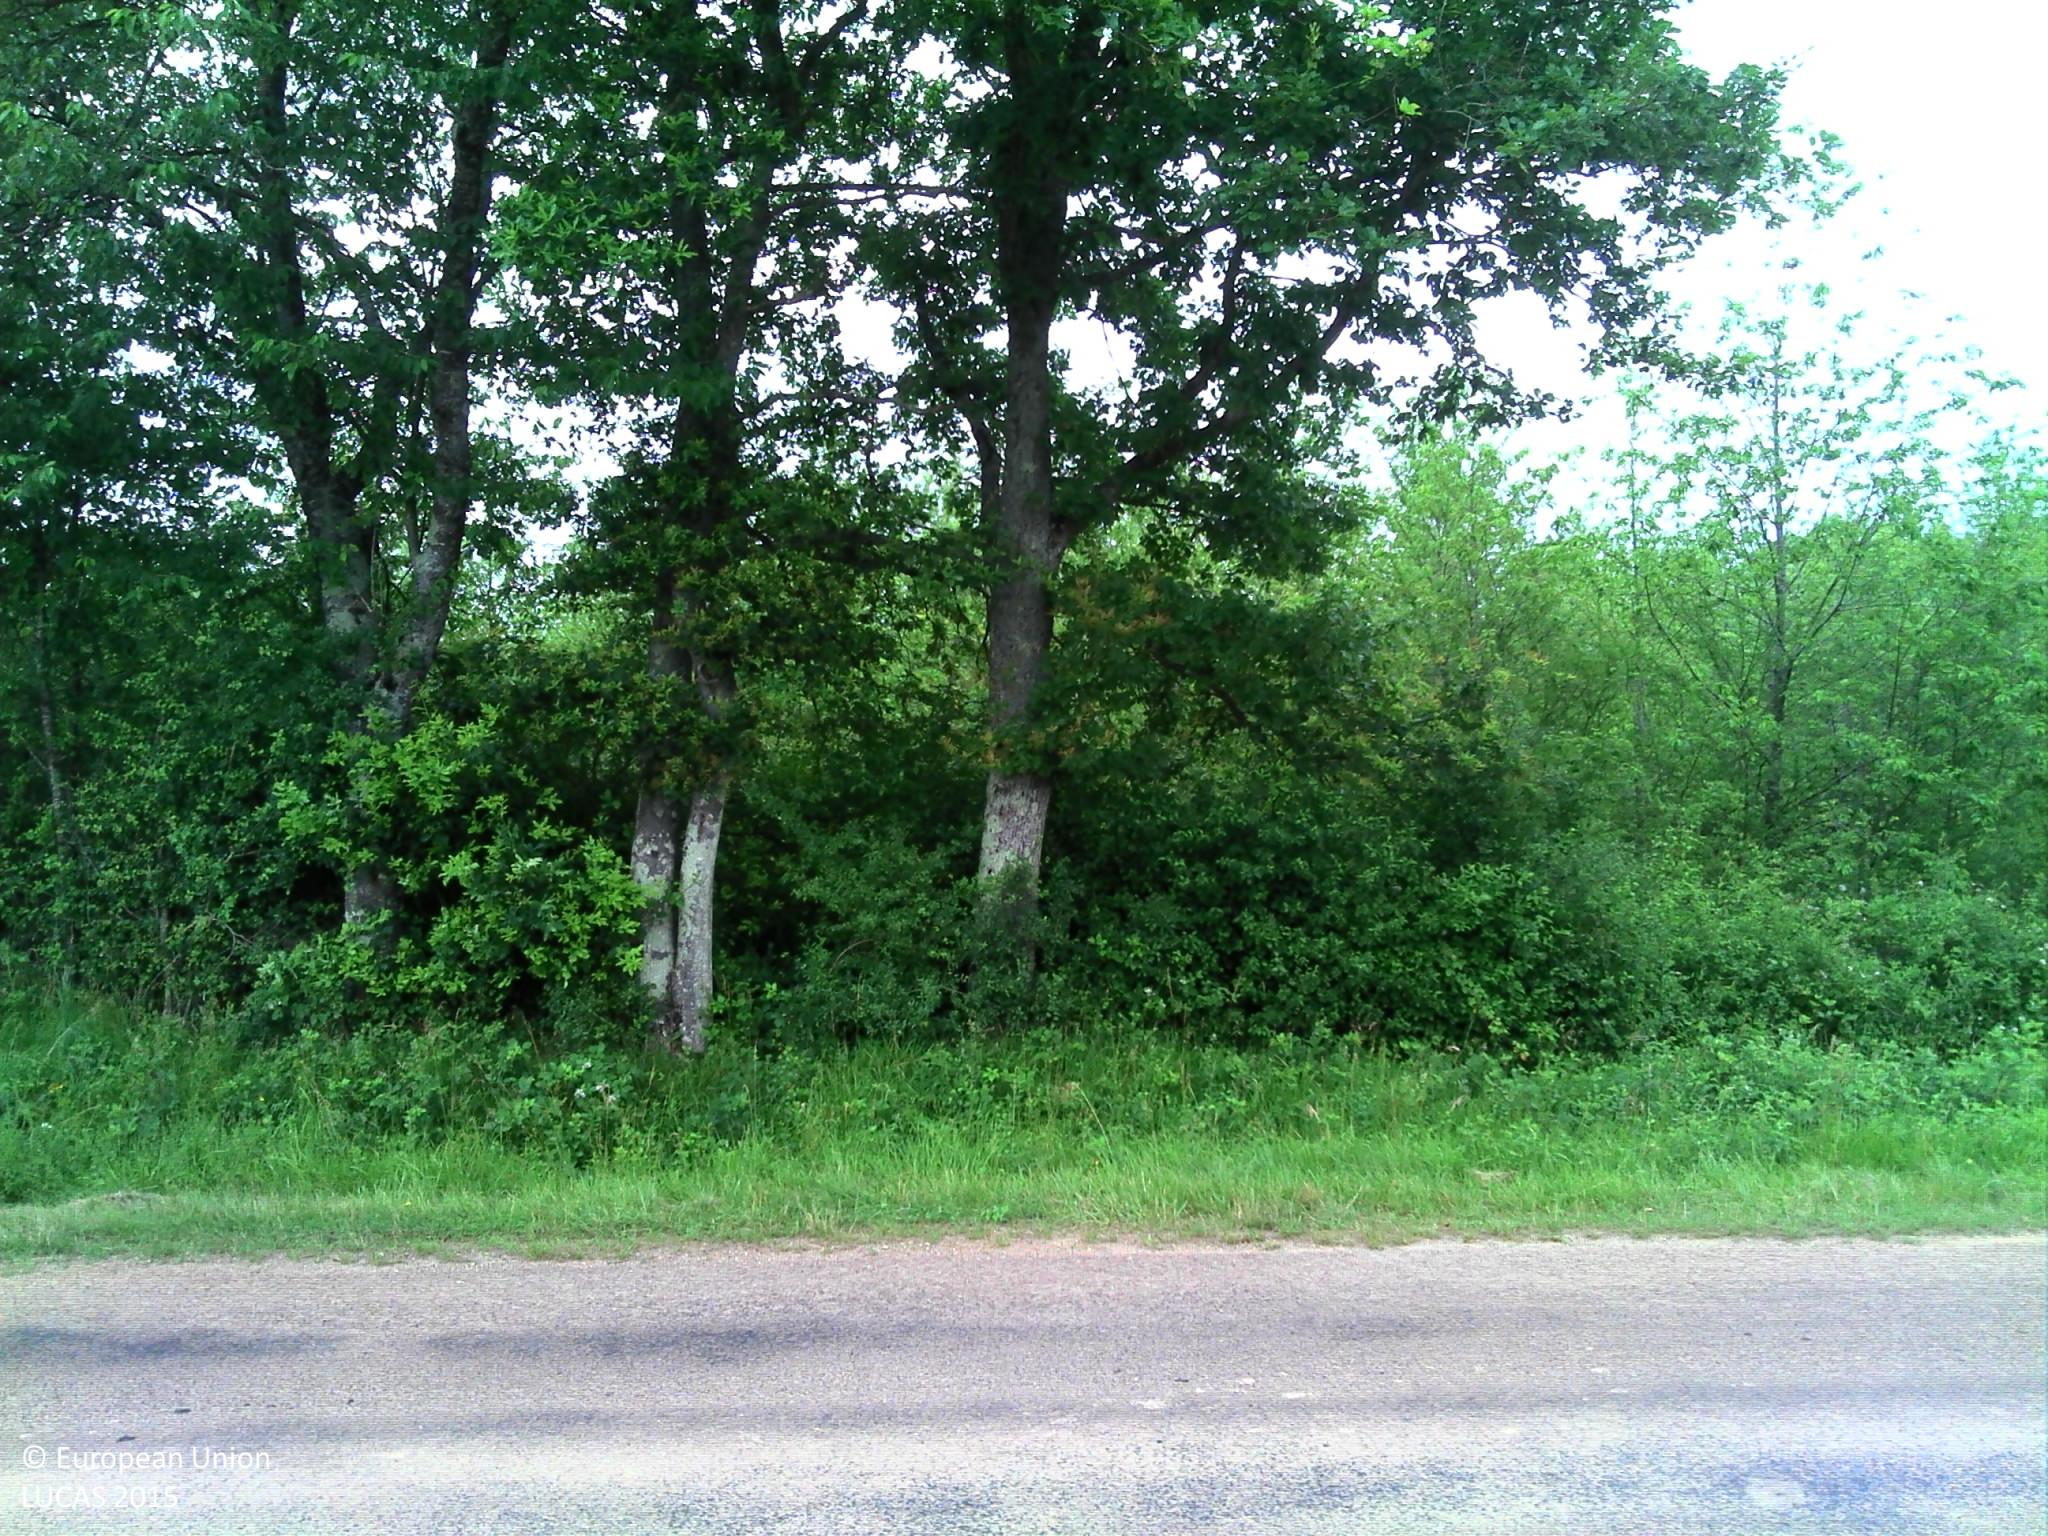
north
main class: Cropland
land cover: Rape and turnip rape
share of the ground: > 75 %
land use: Agriculture (excluding fallow land and kitchen gardens)
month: June
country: FR
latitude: 47.3227
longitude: 3.1285
